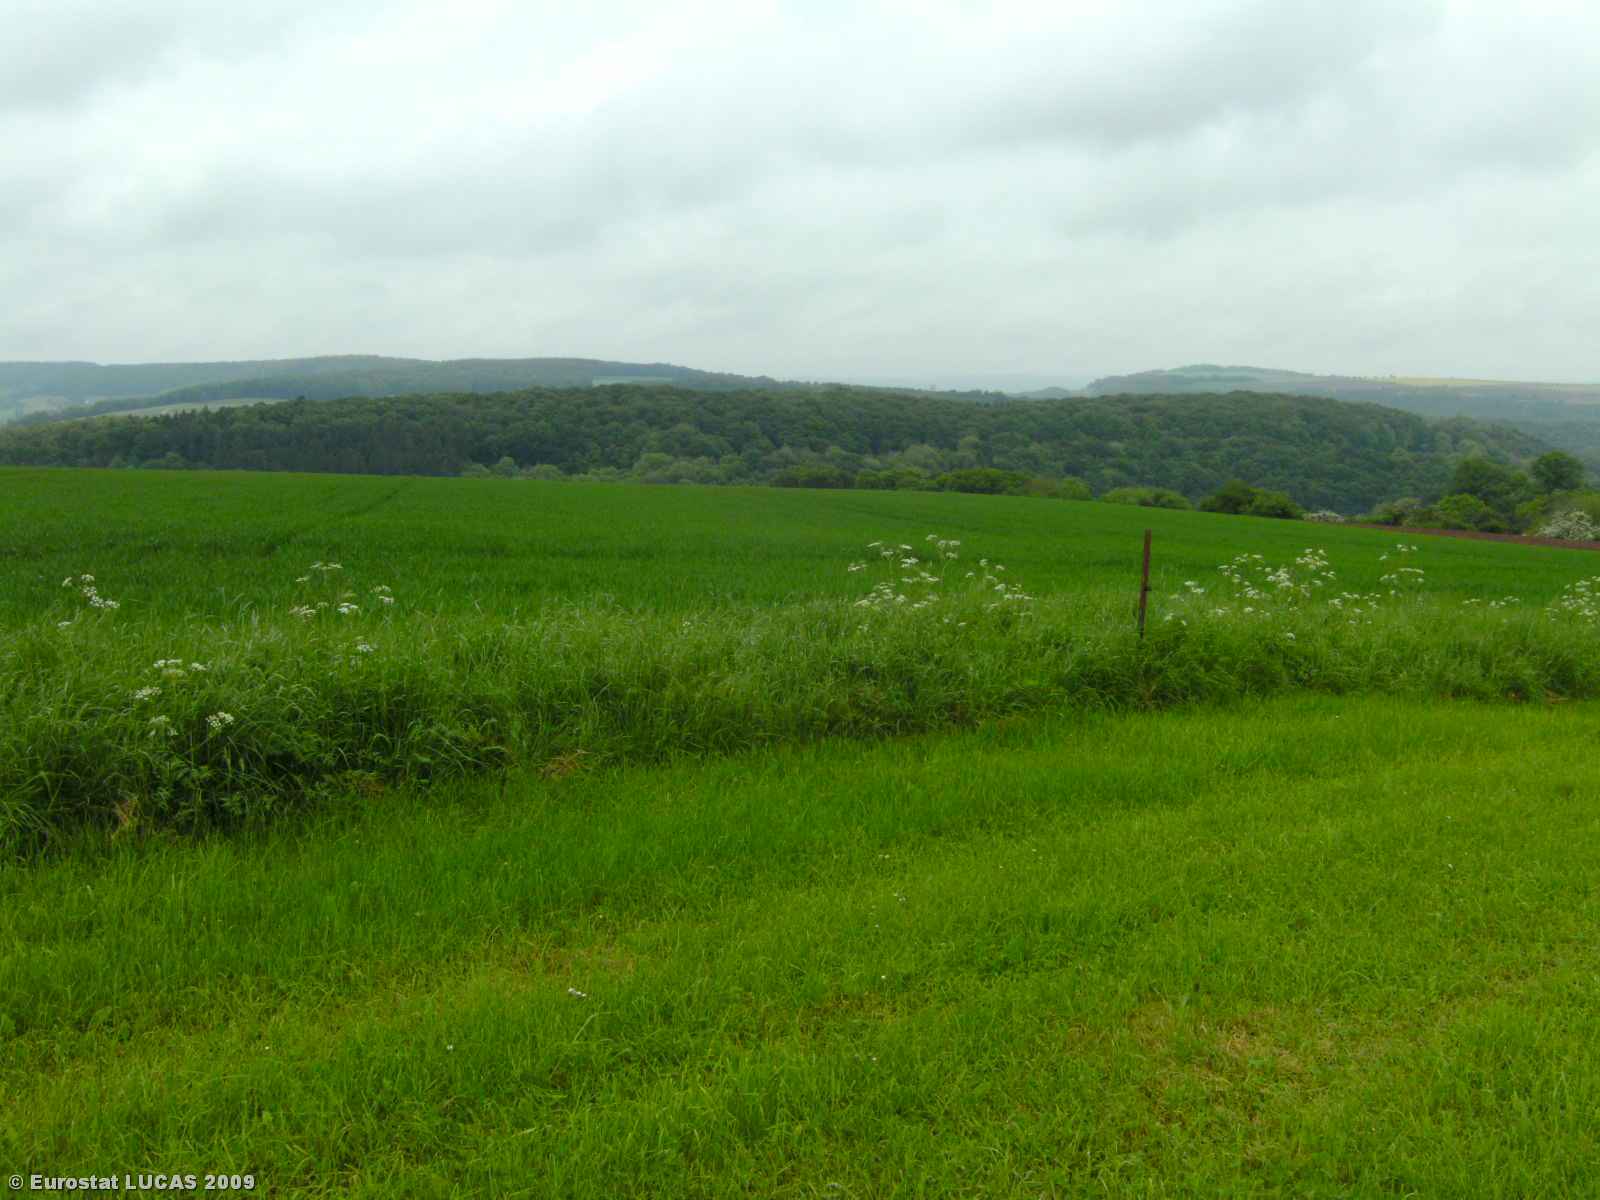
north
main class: Grassland
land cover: Grassland without tree/shrub cover
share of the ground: > 75 %
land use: Agriculture (excluding fallow land and kitchen gardens)
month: May
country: LU
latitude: 49.8528
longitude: 6.2581
